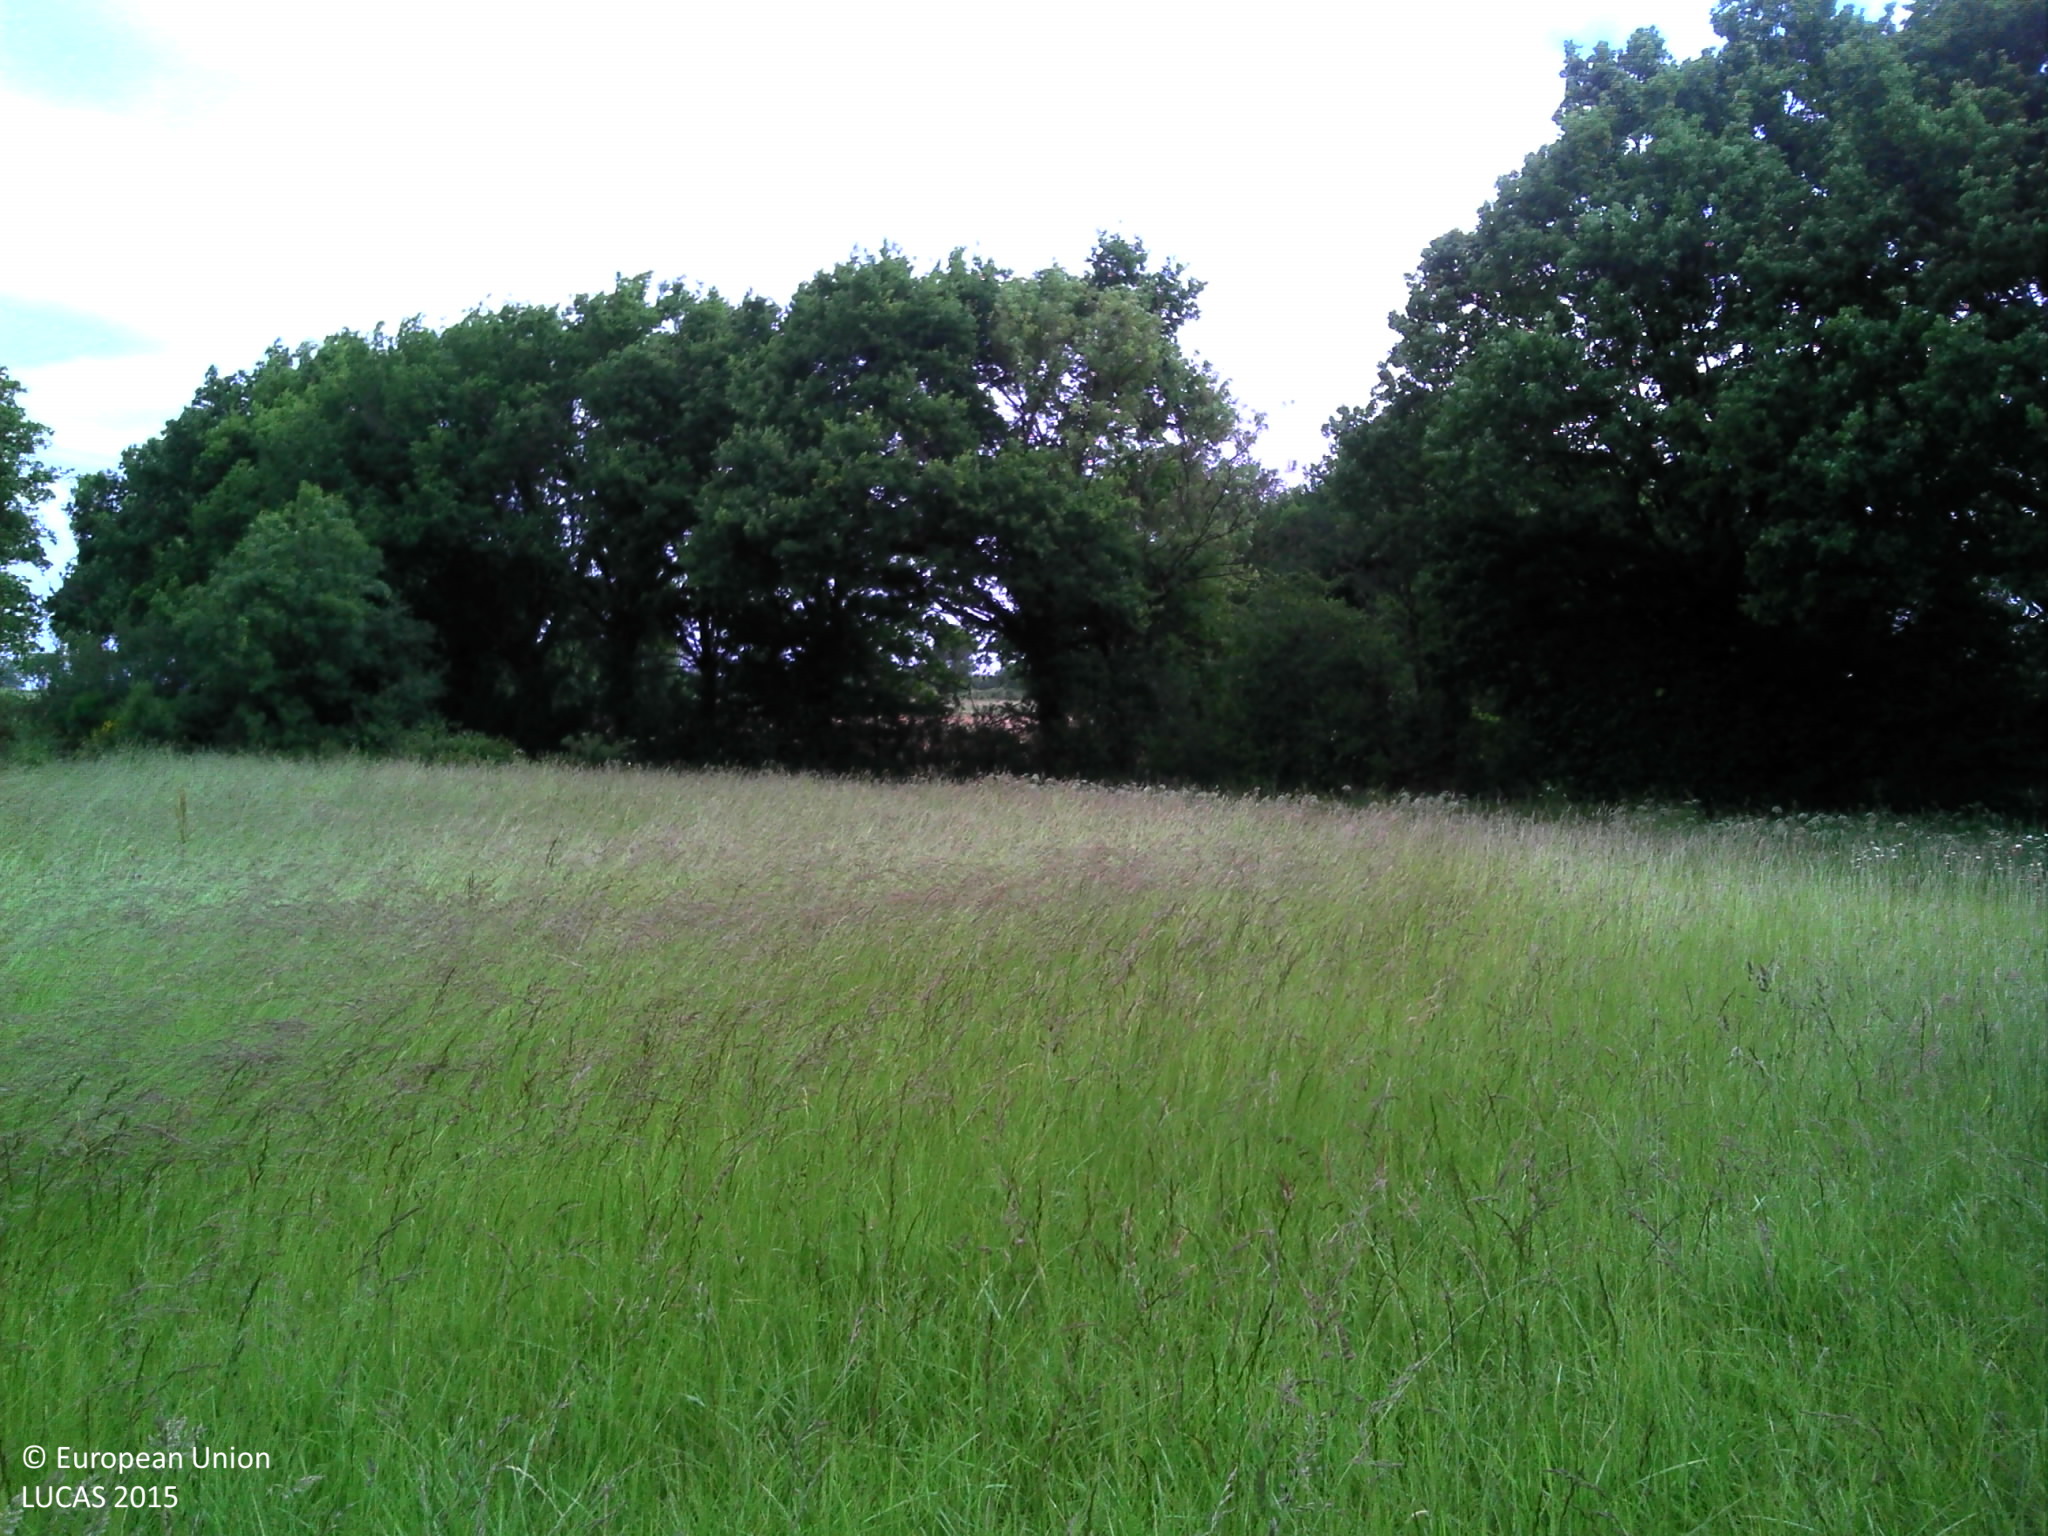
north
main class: Grassland
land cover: Grassland without tree/shrub cover
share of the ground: > 75 %
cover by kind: herbaceous plants 100 %
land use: Agriculture (excluding fallow land and kitchen gardens)
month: June
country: FR
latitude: 47.2277
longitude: -1.2513
